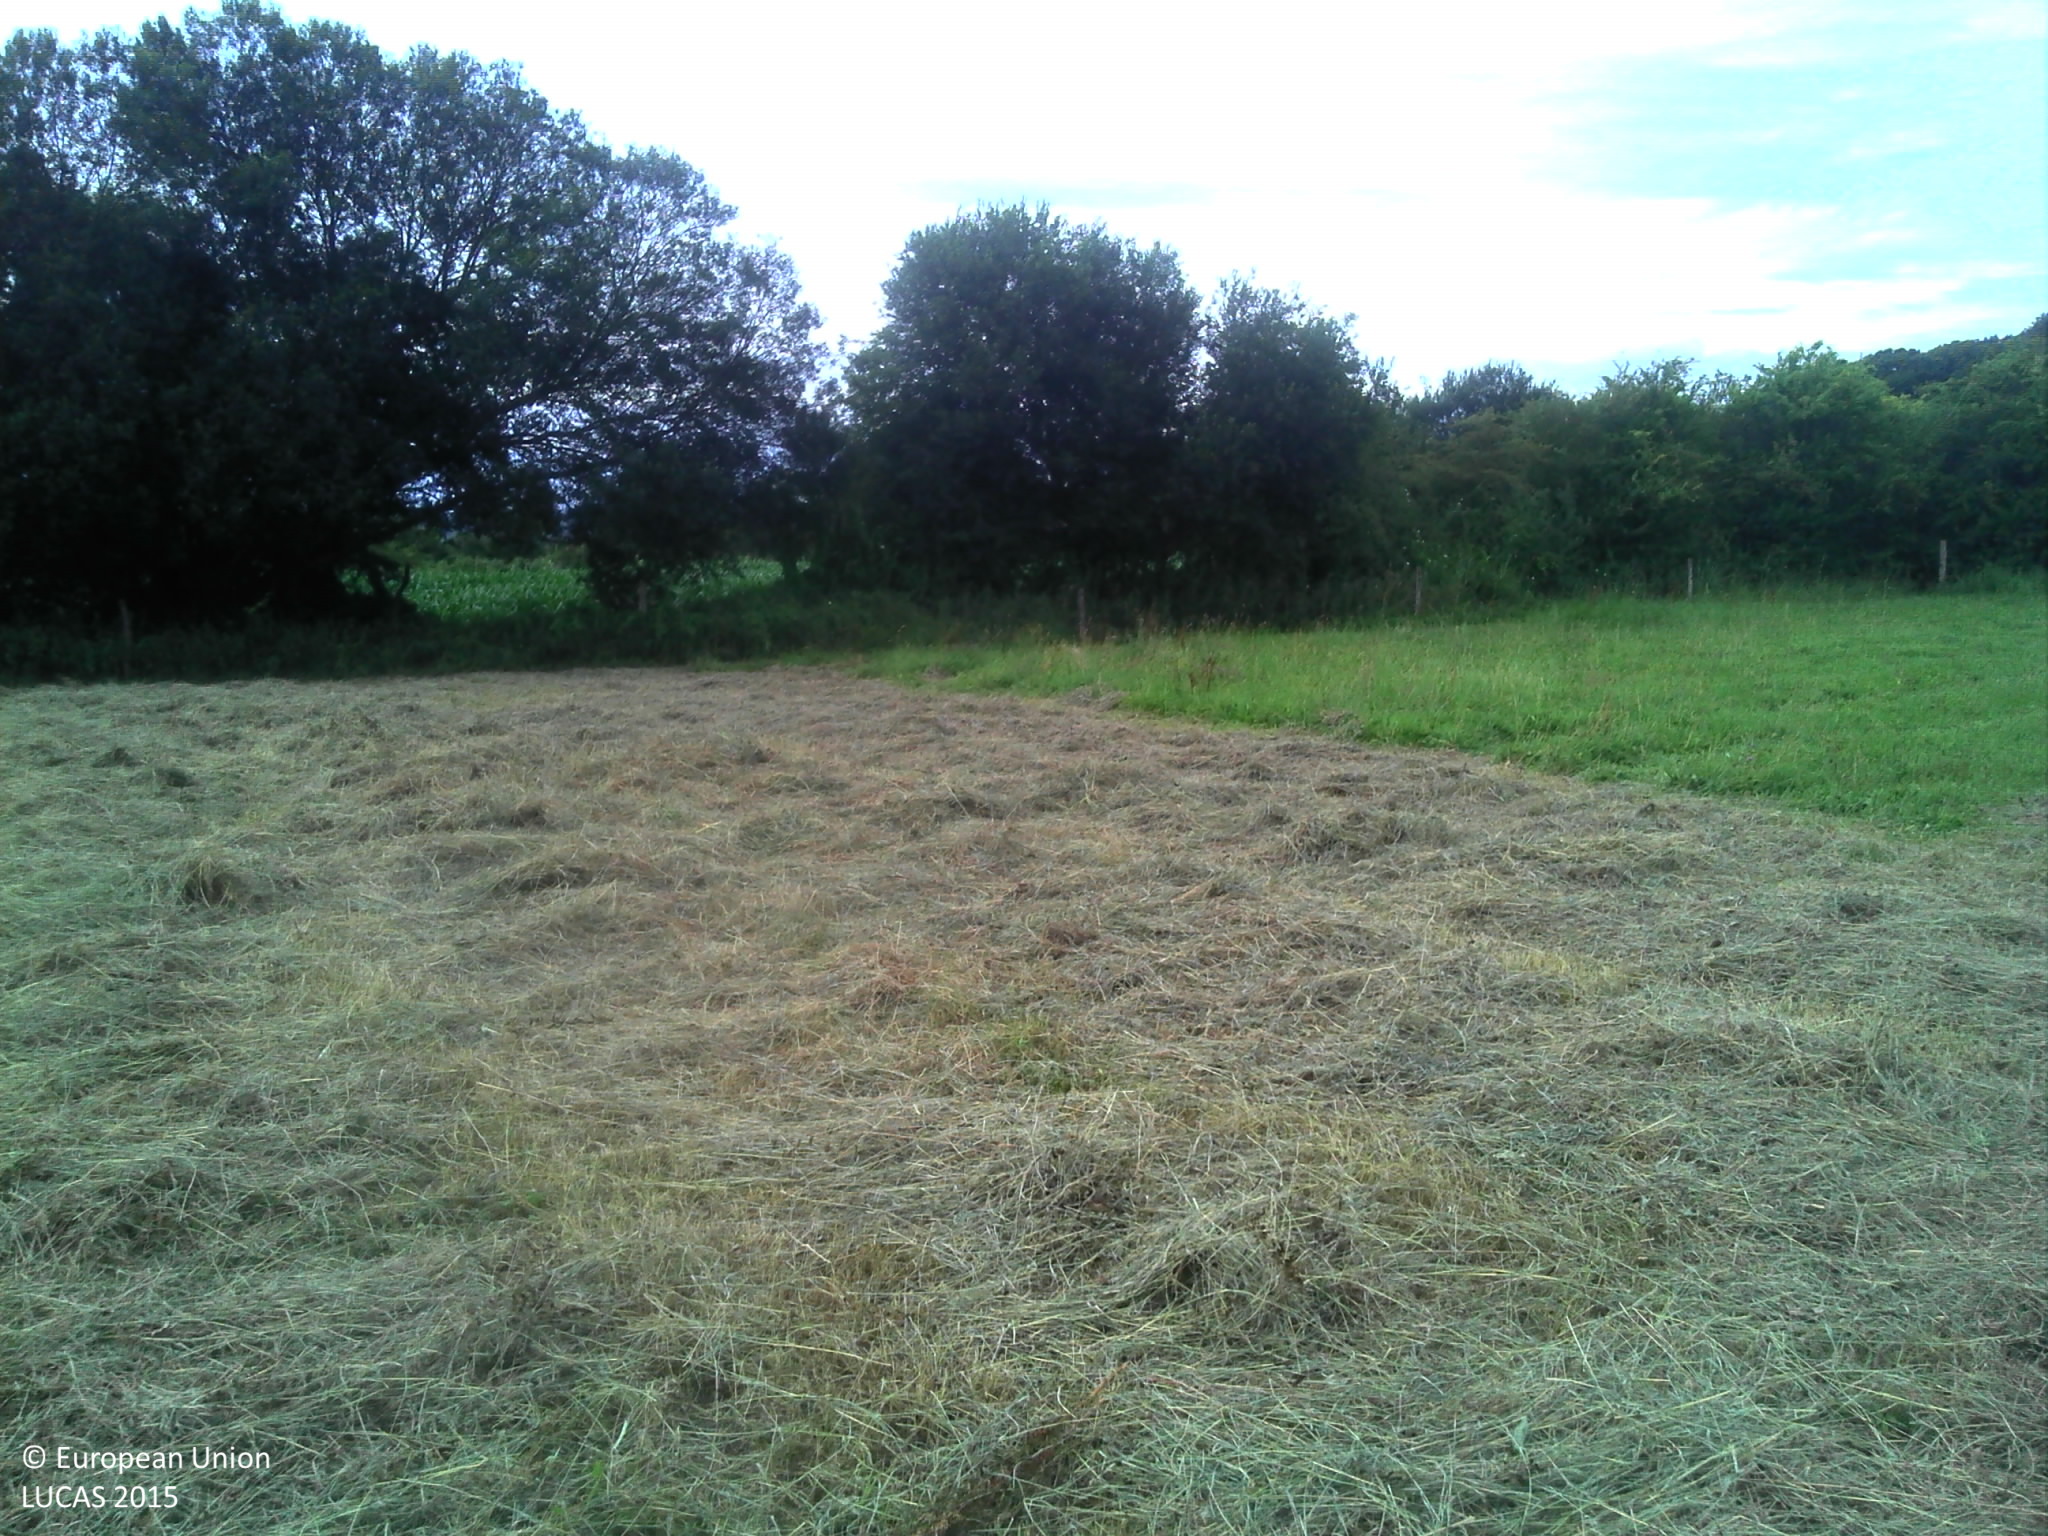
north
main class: Grassland
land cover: Grassland without tree/shrub cover
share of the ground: > 75 %
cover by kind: herbaceous plants 100 %
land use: Agriculture (excluding fallow land and kitchen gardens)
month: July
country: FR
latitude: 48.6917
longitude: -1.4998
